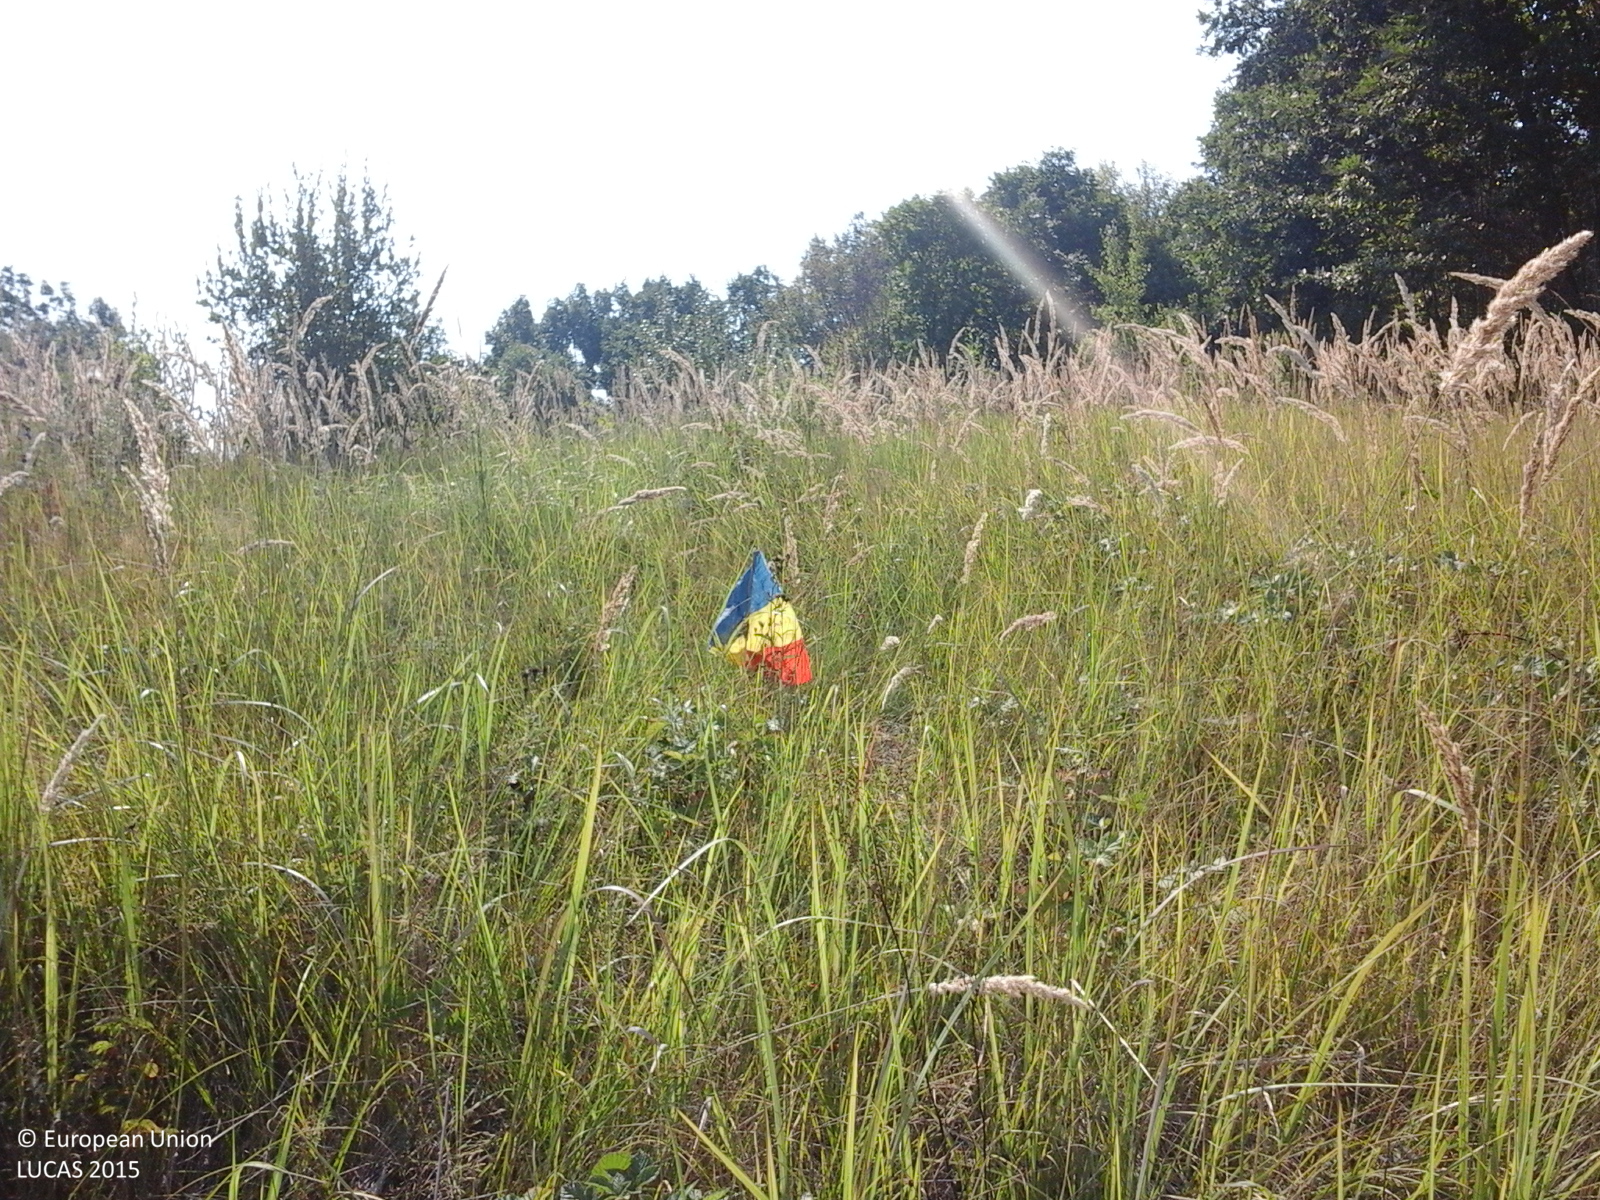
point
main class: Grassland
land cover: Spontaneously vegetated surfaces
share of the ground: > 75 %
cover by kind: herbaceous plants 100 %
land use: Semi-natural and natural areas not in use
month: August
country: RO
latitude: 46.2802
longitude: 22.1011
